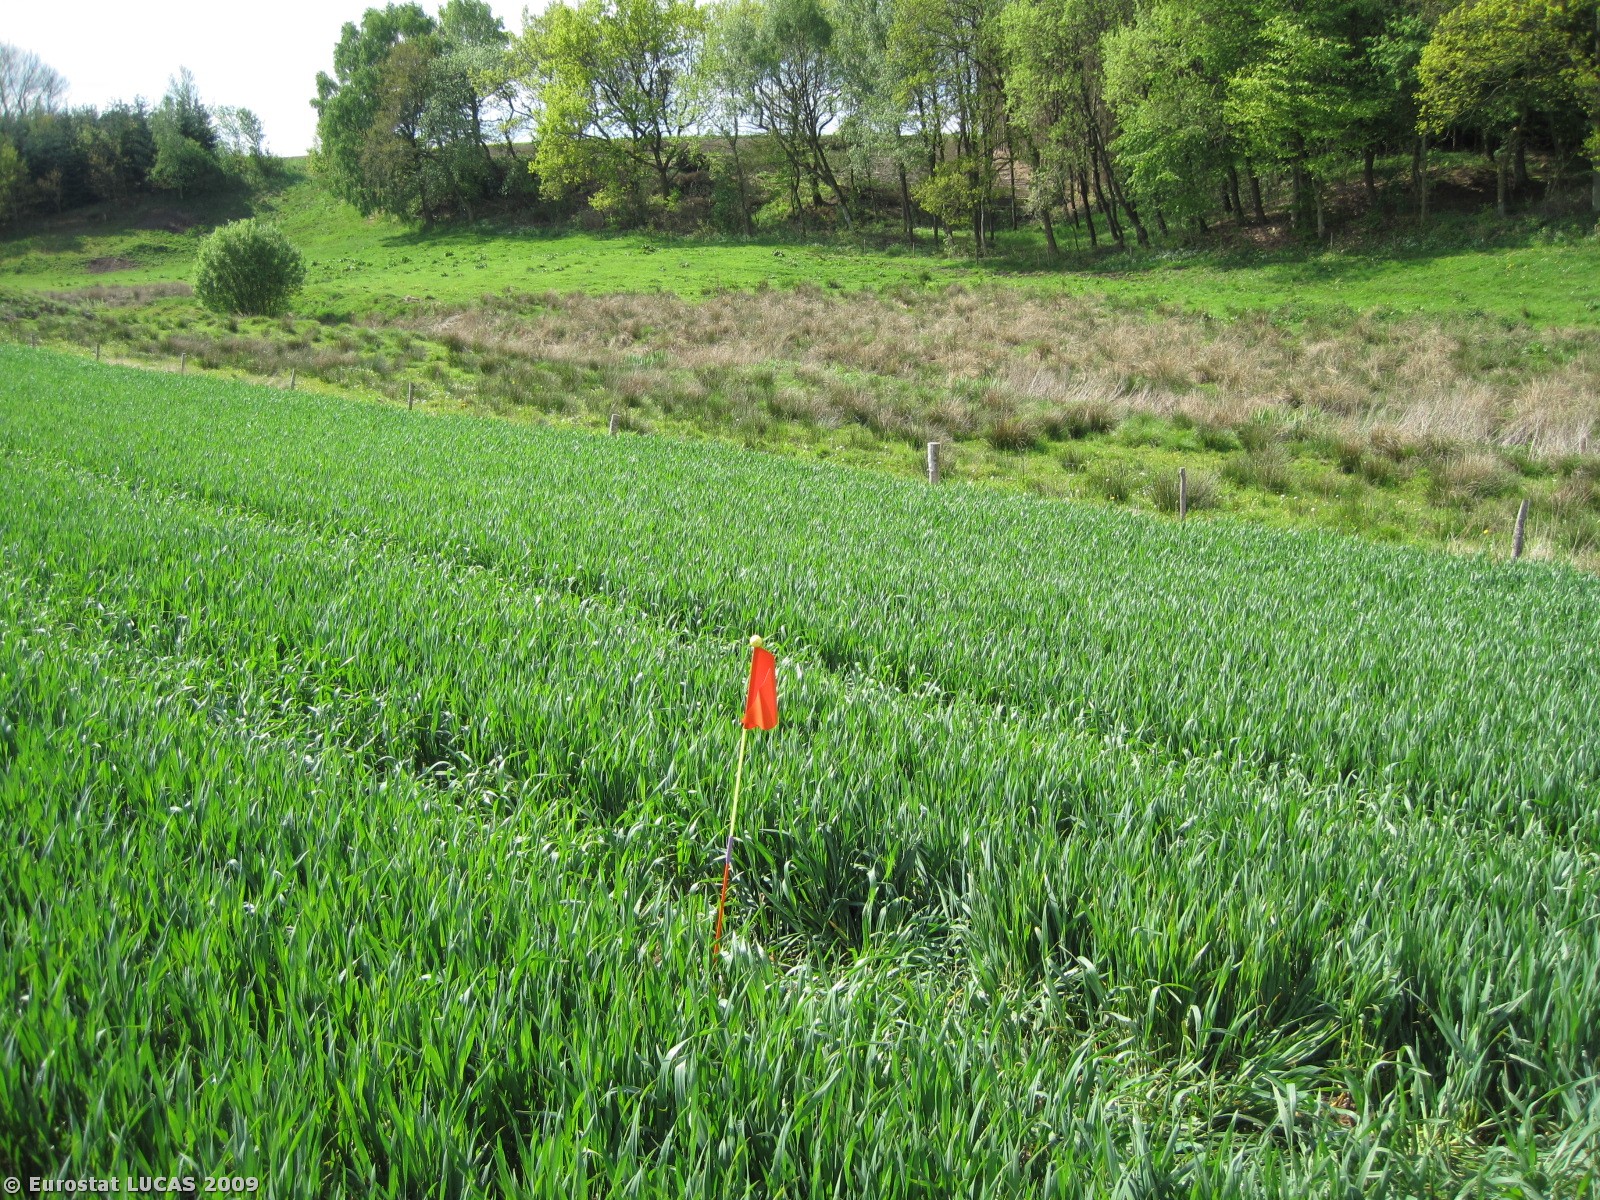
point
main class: Cropland
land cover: Common wheat
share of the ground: > 75 %
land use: Agriculture (excluding fallow land and kitchen gardens)
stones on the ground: < 10 %
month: May
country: DK
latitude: 56.3133
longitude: 9.7255
